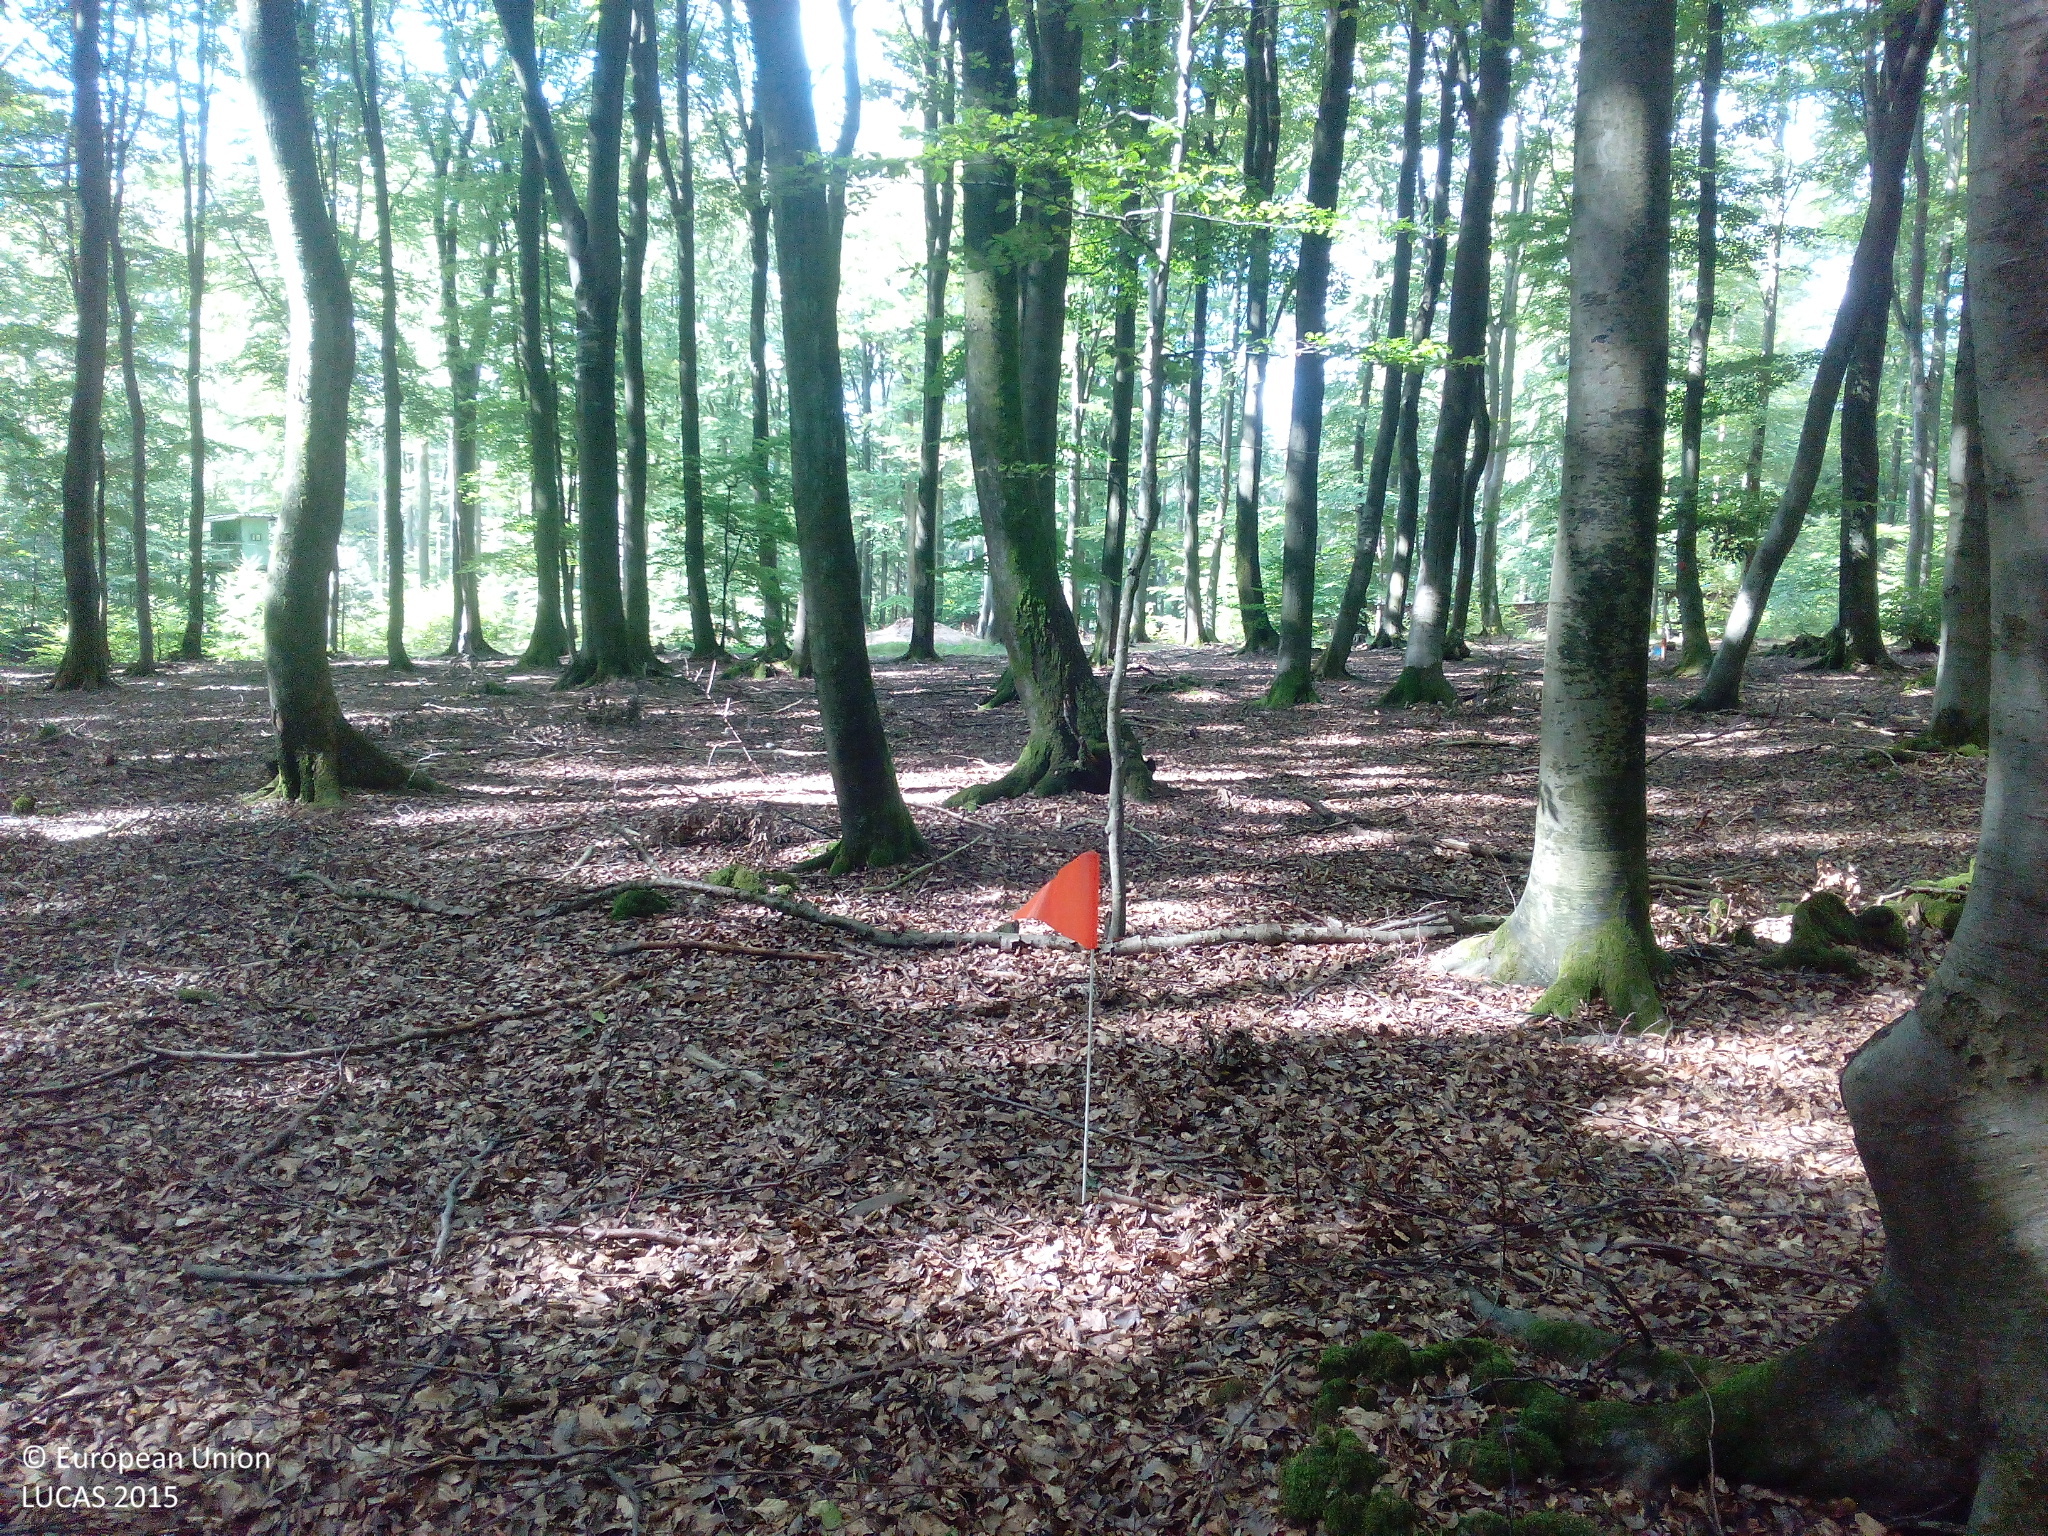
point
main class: Woodland
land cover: Broadleaved woodland
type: beech forest
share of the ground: > 75 %
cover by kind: broadleaved forest trees 90 %, unconsolidated bare surface 10 %
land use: Forestry
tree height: > 5 m
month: September
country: DE
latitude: 49.9496
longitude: 9.5681
